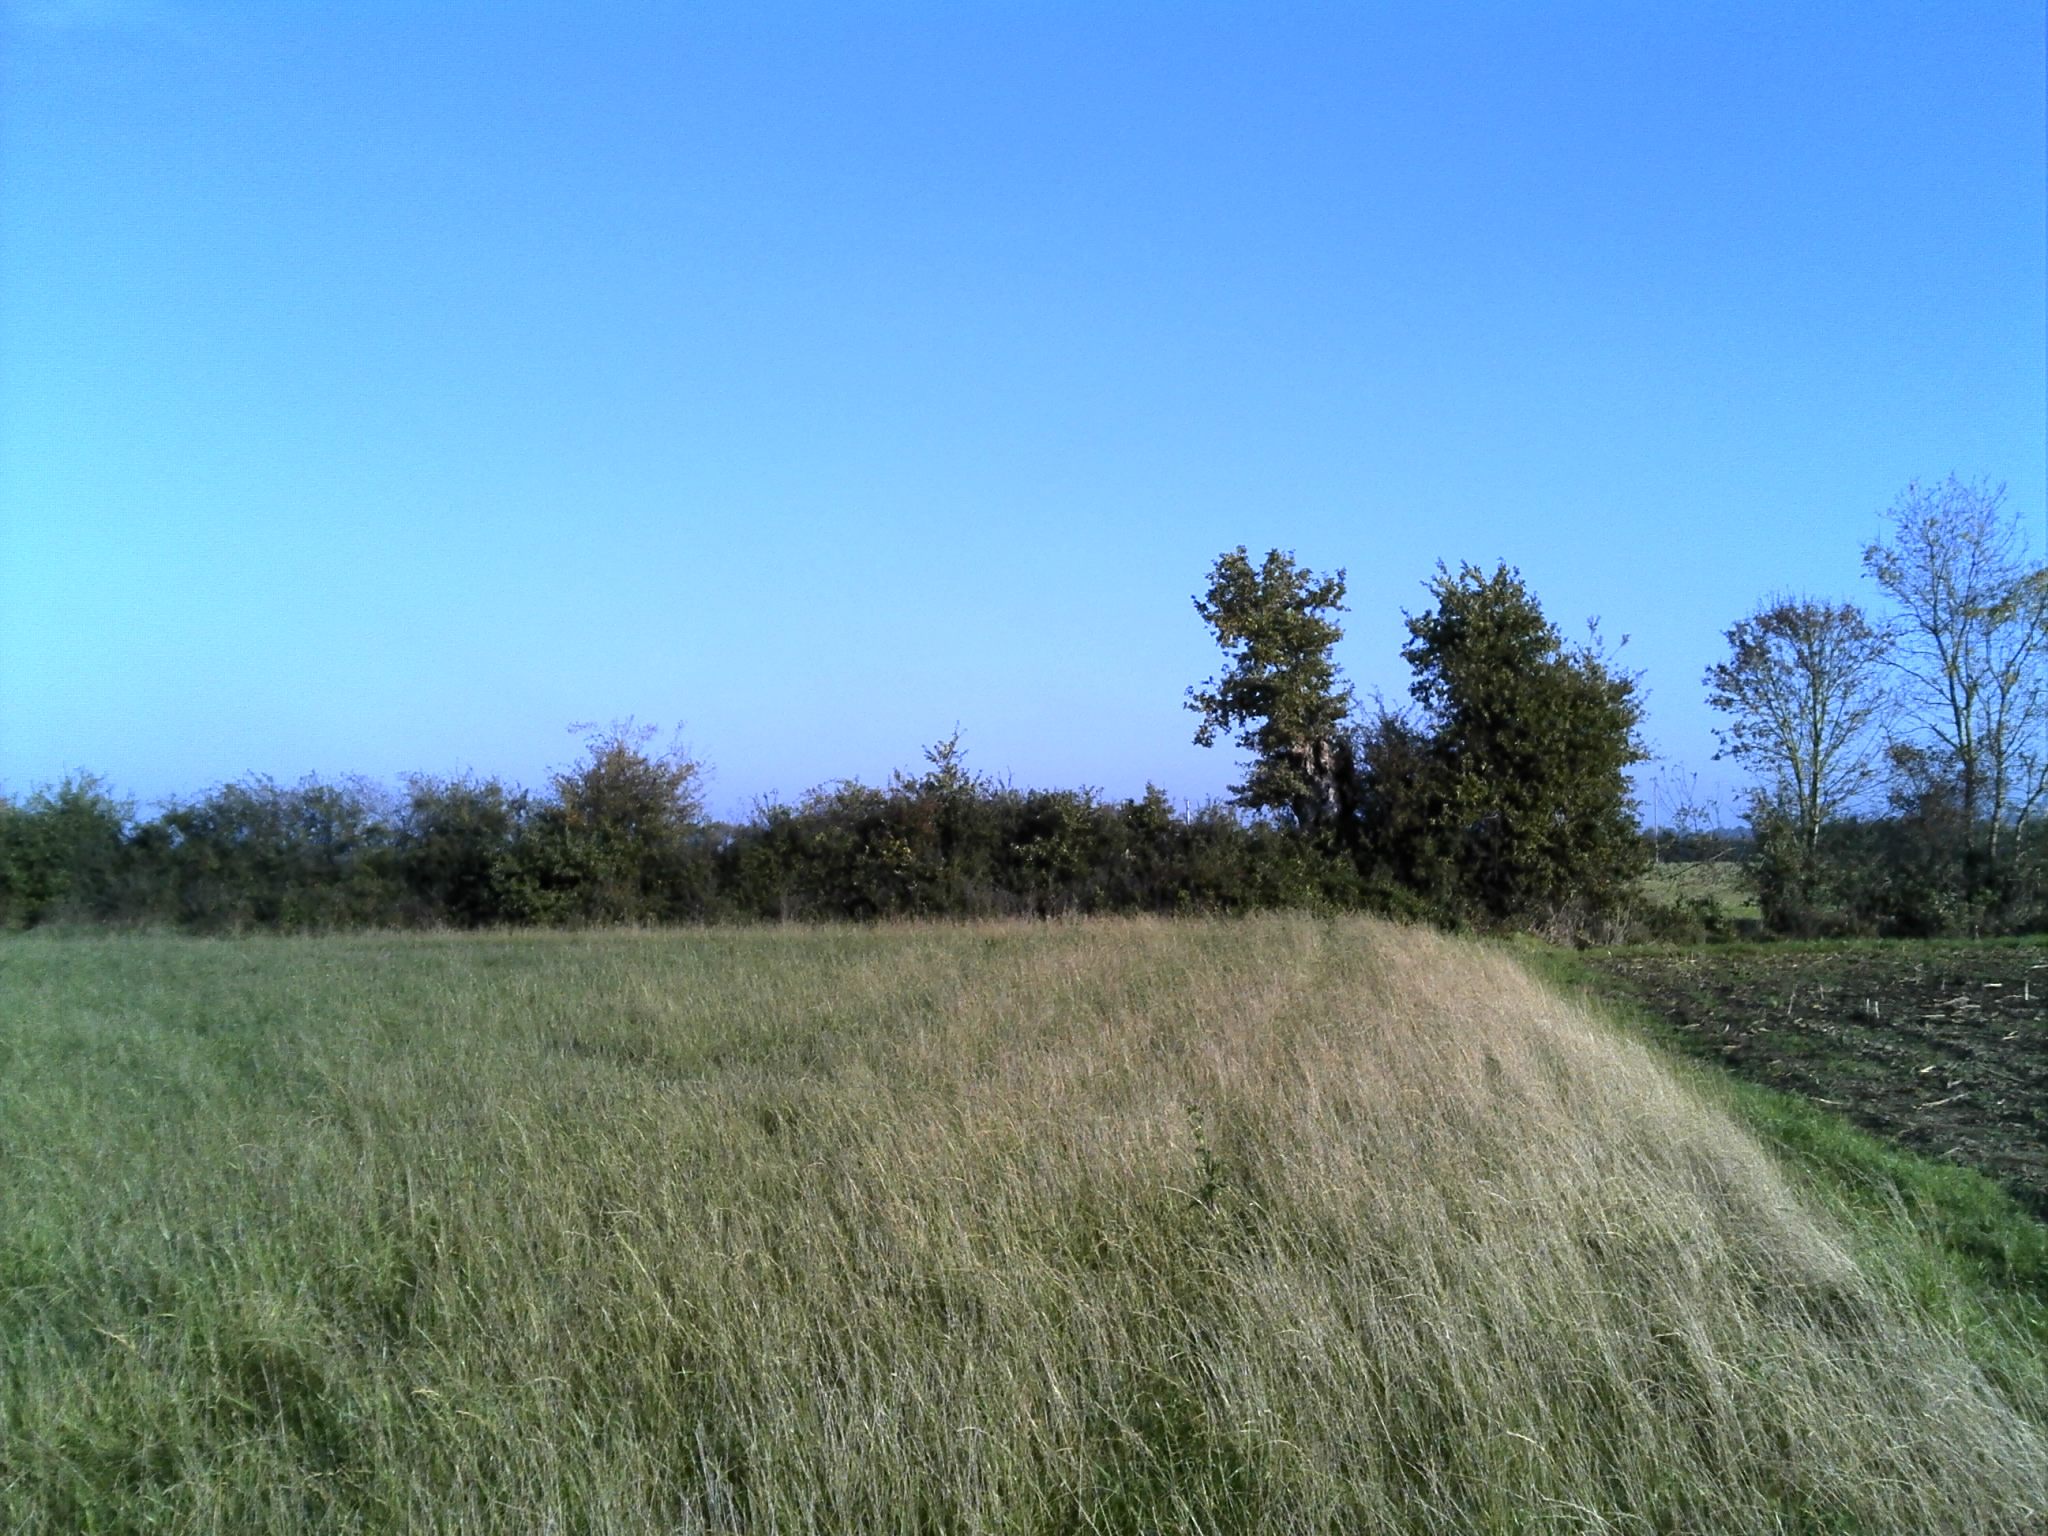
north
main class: Cropland
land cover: Temporary grasslands
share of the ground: > 75 %
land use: Agriculture (excluding fallow land and kitchen gardens)
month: October
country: FR
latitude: 47.3408
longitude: -1.0349
